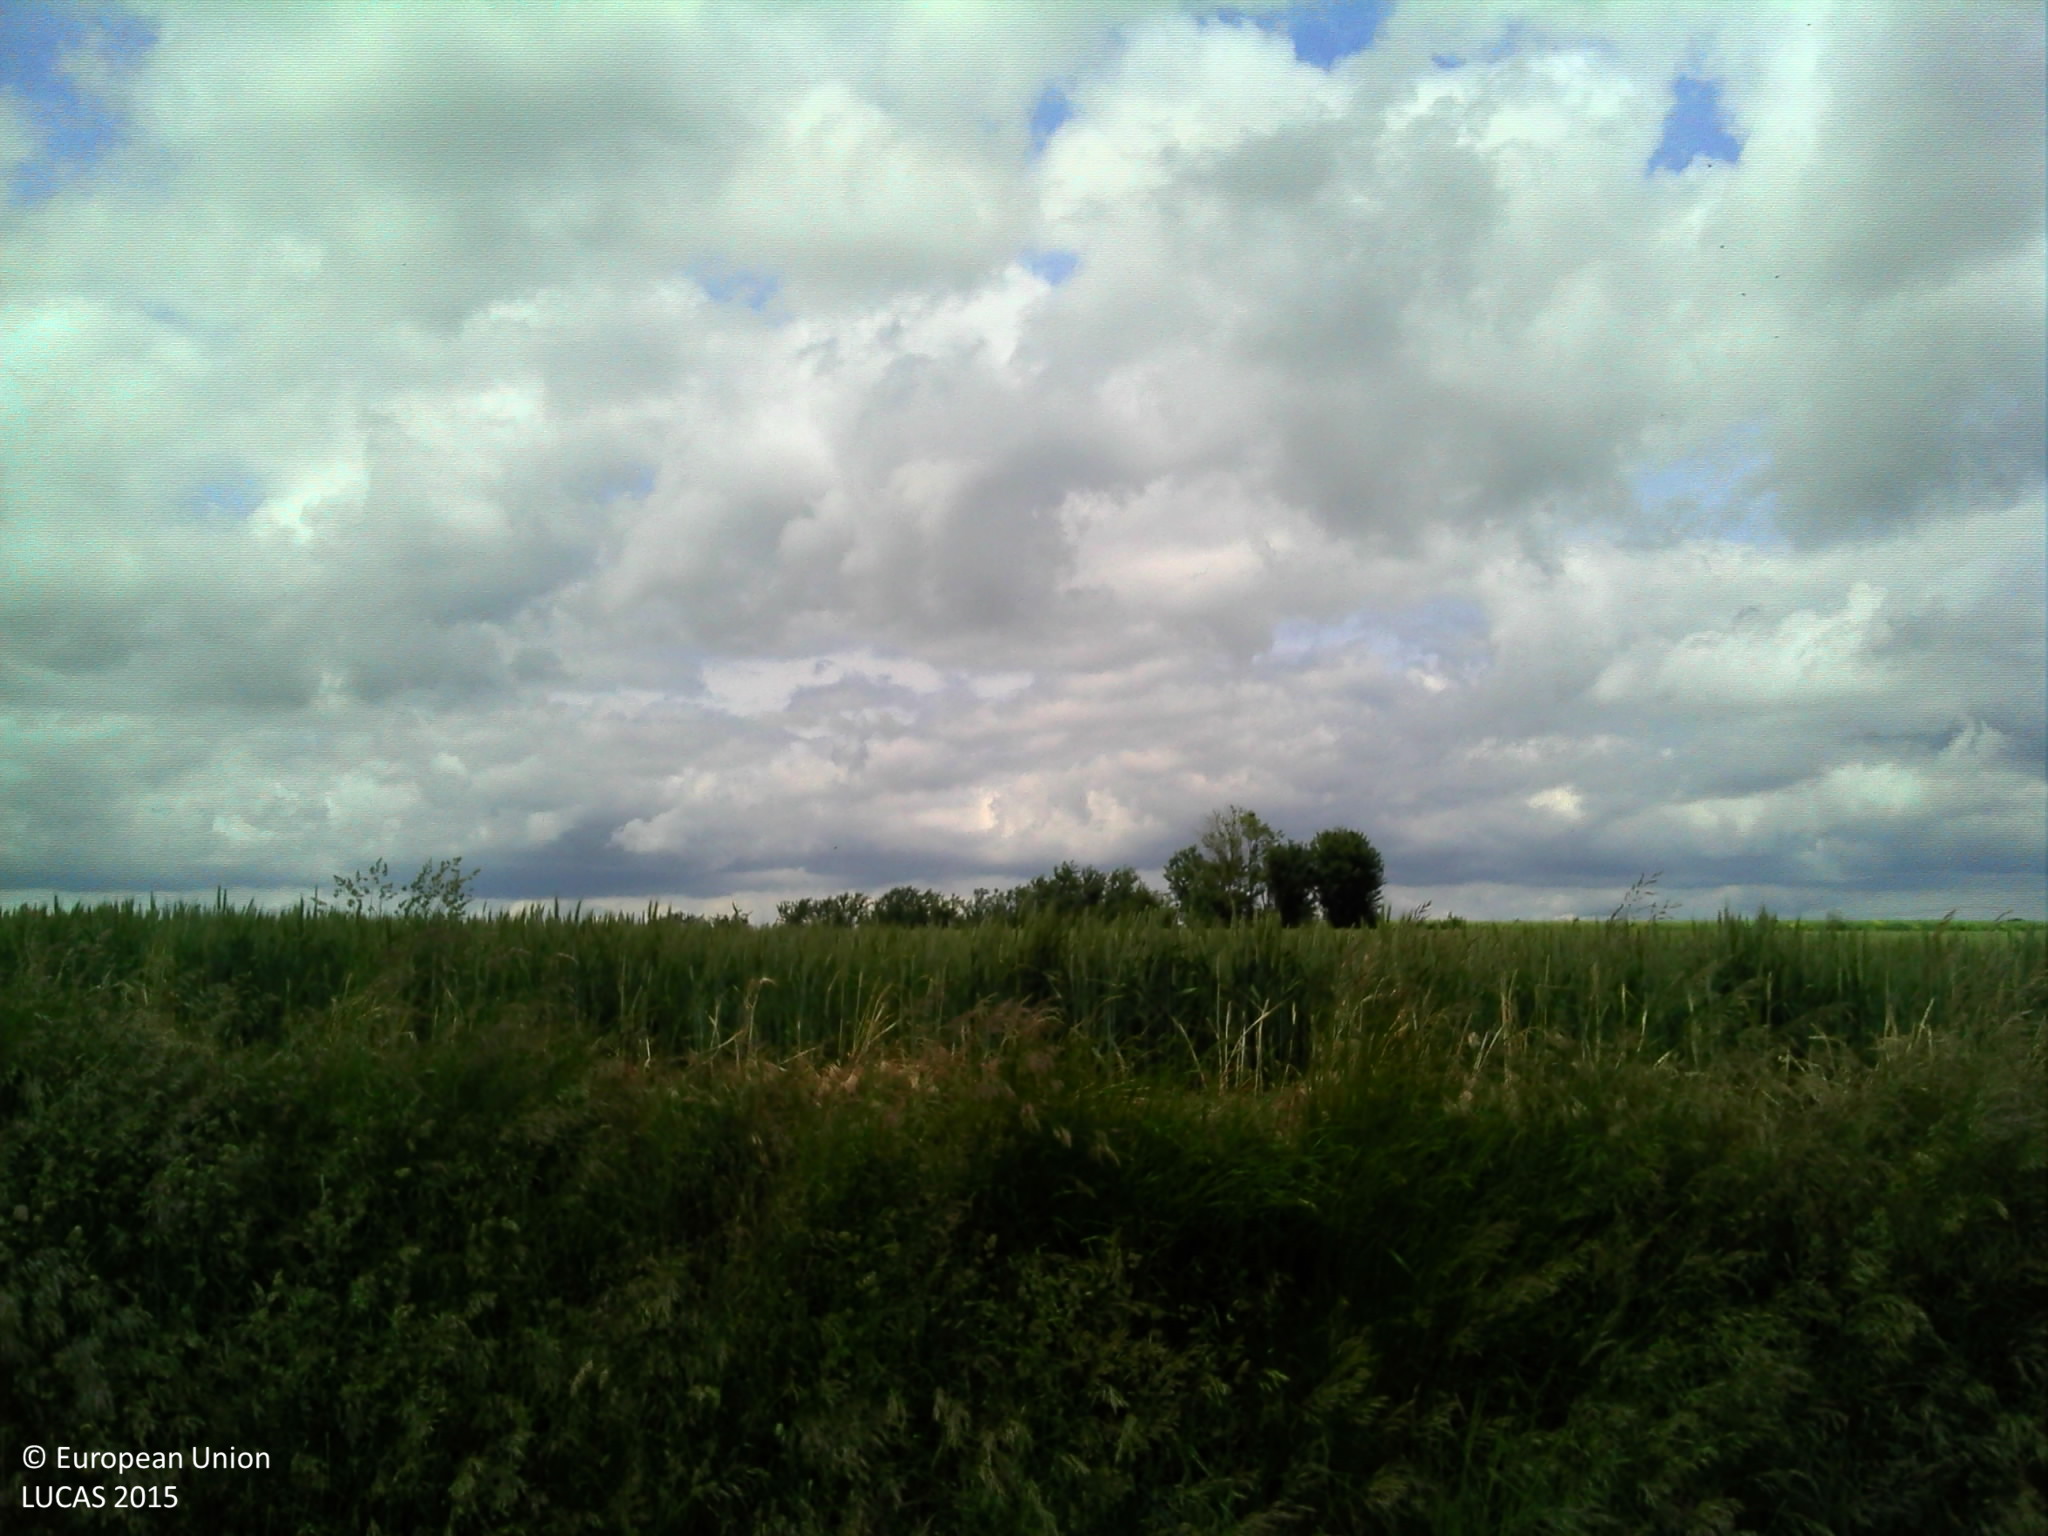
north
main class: Cropland
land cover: Barley
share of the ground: > 75 %
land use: Agriculture (excluding fallow land and kitchen gardens)
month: May
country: FR
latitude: 48.0759
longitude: -0.0009
